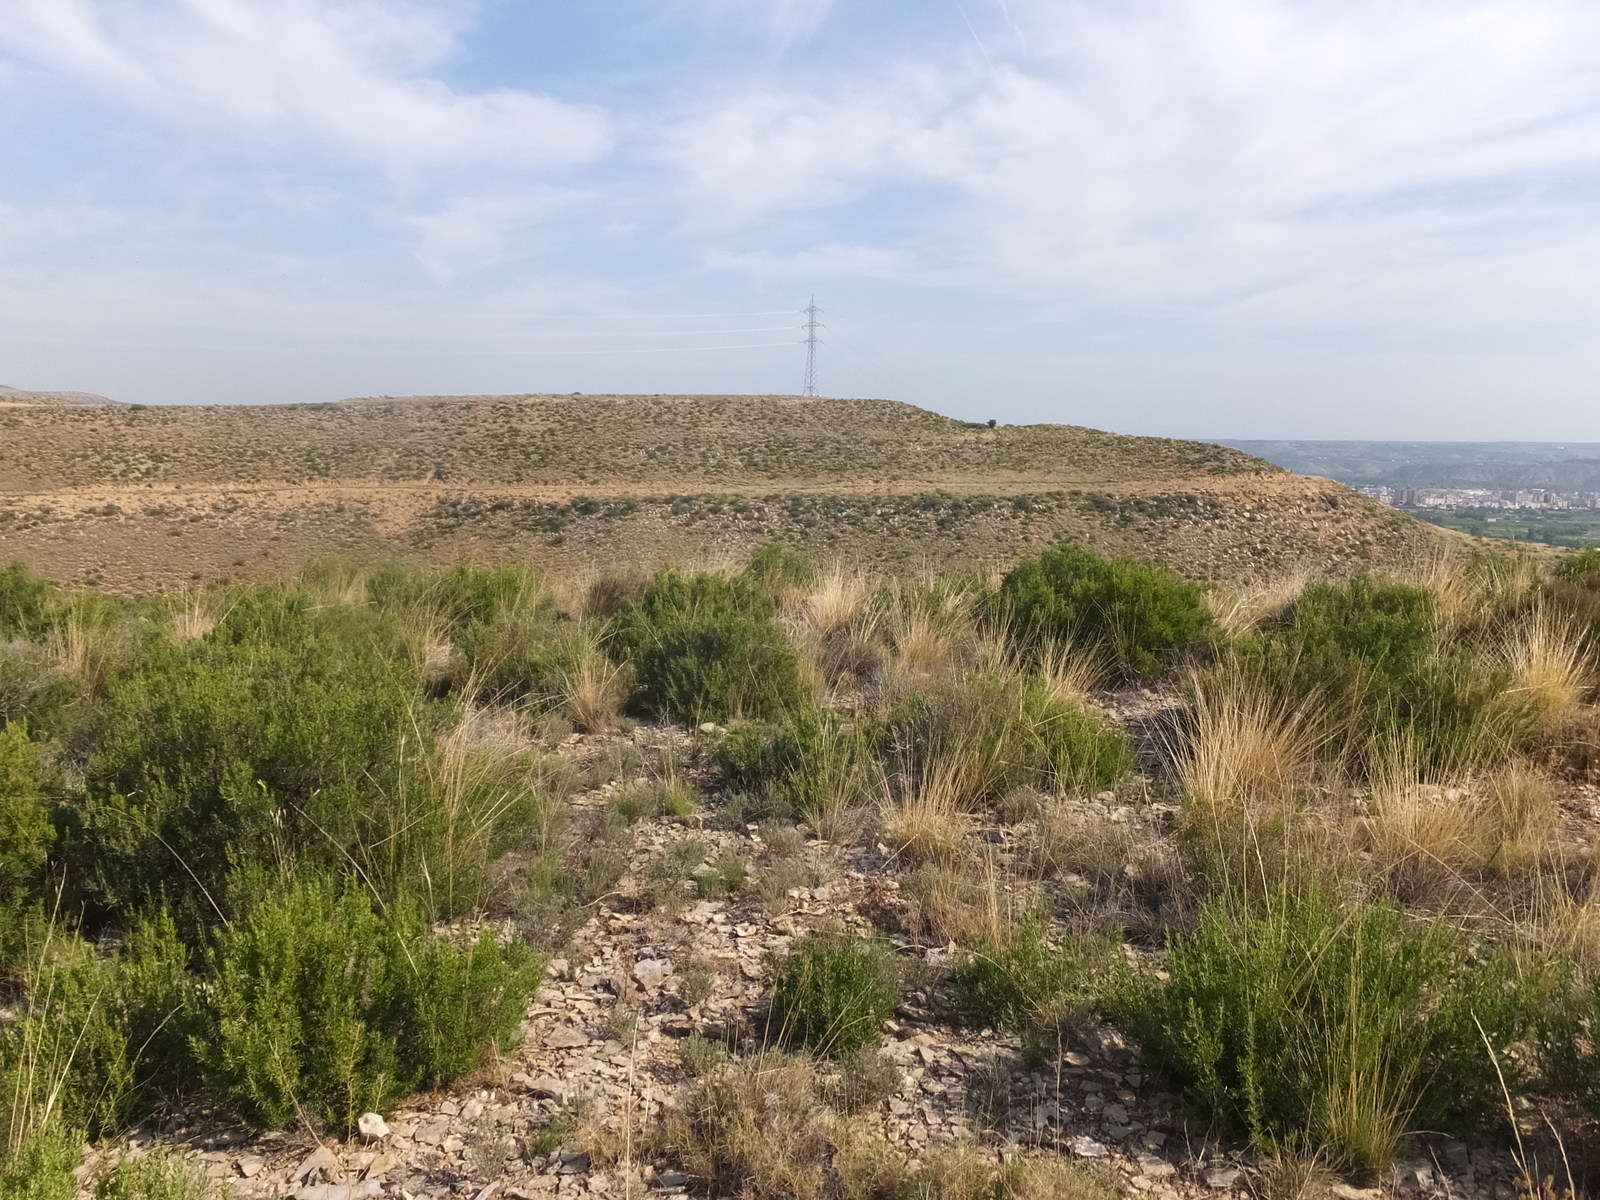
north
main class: Shrubland
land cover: Shrubland without tree cover
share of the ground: > 75 %
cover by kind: shrubs 60 %, herbaceous plants 25 %, consolidated bare surface 15 %
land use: Semi-natural and natural areas not in use
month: August
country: ES
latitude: 41.4984
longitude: 0.3200
